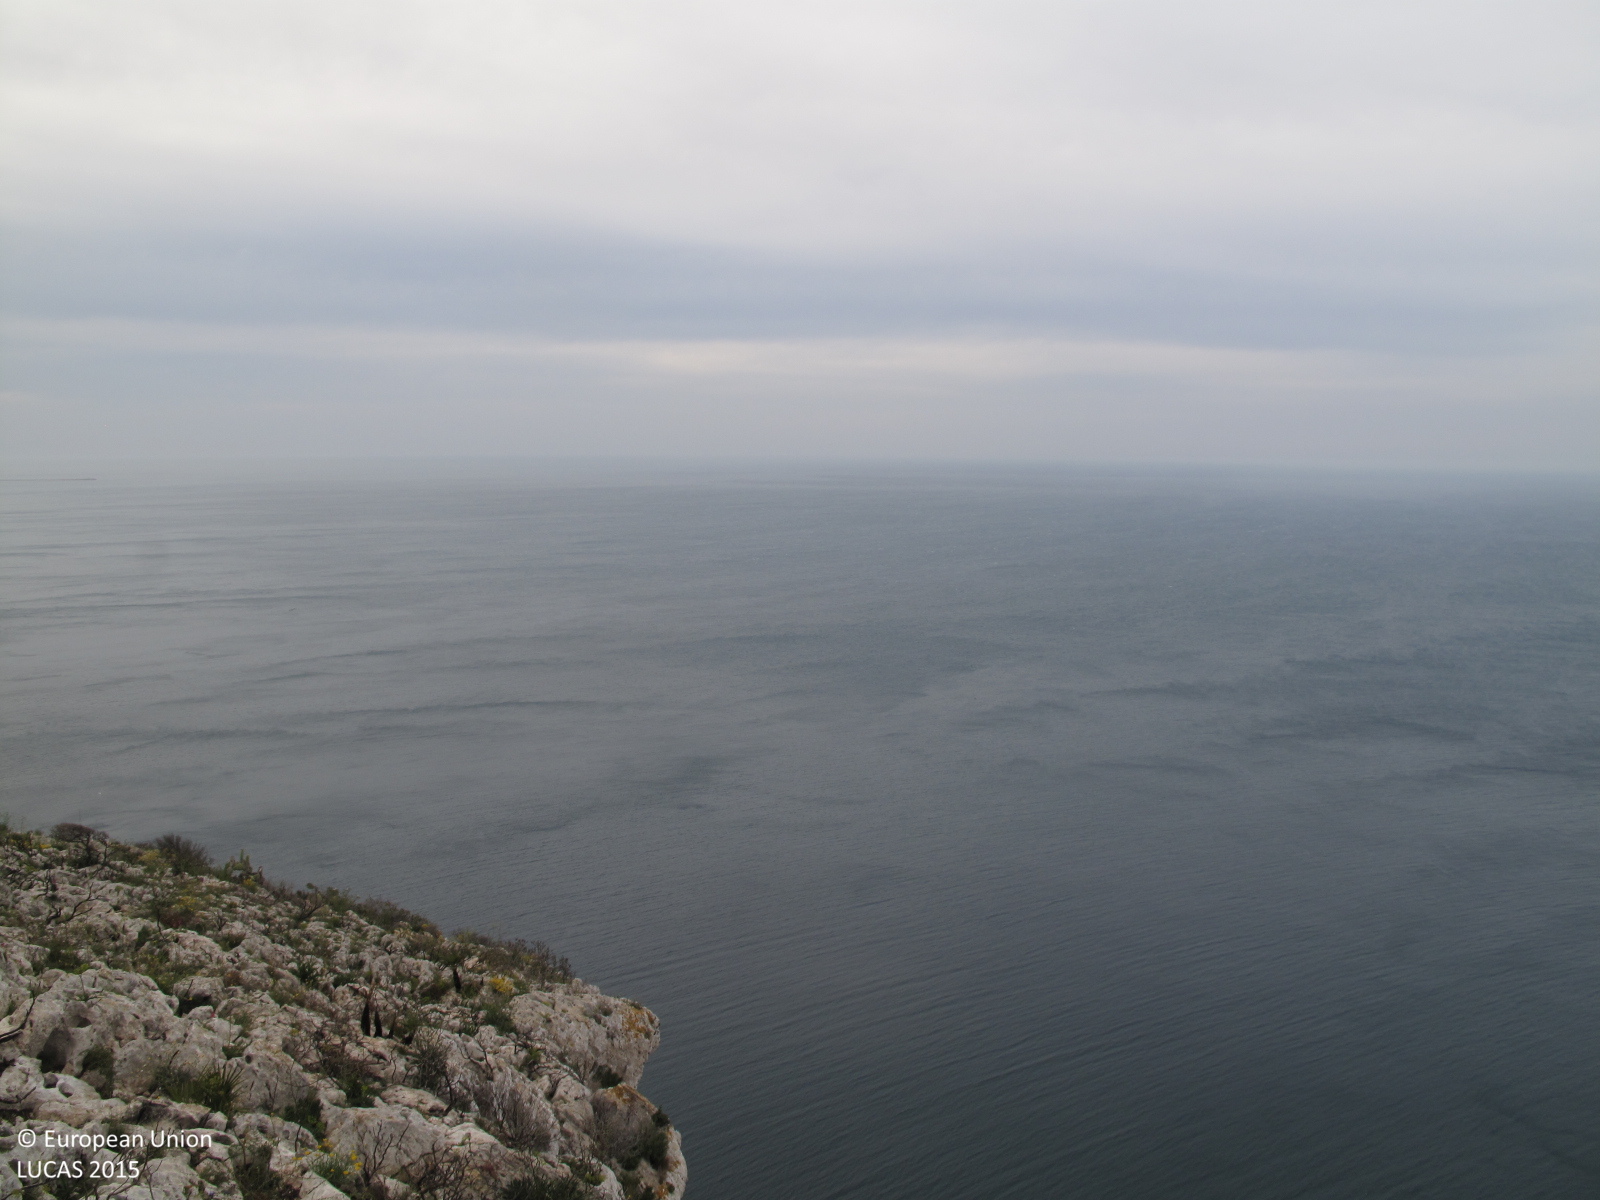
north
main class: Grassland
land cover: Grassland with sparse tree/shrub cover
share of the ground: 10 - 25 %
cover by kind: consolidated bare surface 80 %, herbaceous plants 10 %, broadleaved forest trees 5 %, shrubs 5 %
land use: Semi-natural and natural areas not in use
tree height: < 5 m
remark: Burnt area
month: April
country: ES
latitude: 38.8084
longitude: 0.1888
